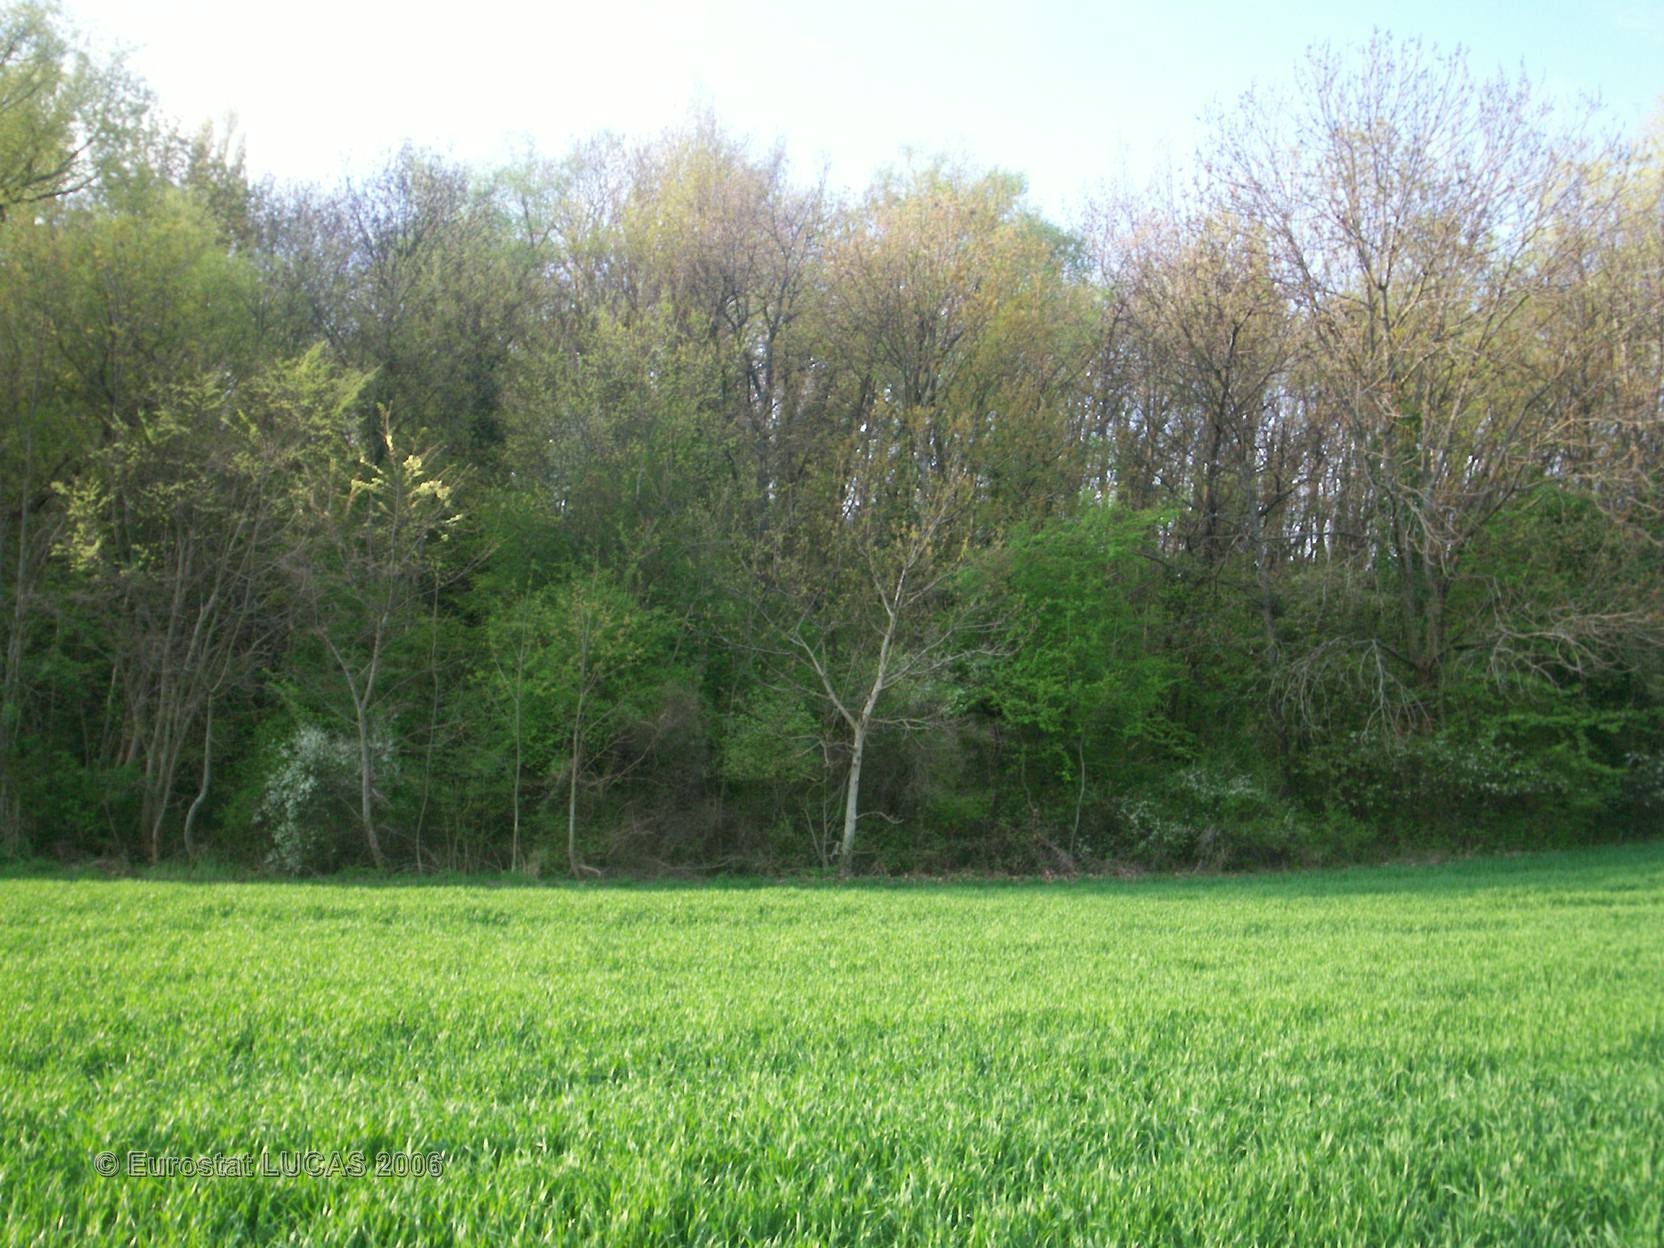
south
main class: Cropland
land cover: Common wheat
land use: Agriculture (excluding fallow land and kitchen gardens)
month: April
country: FR
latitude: 45.8202
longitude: 3.0879
